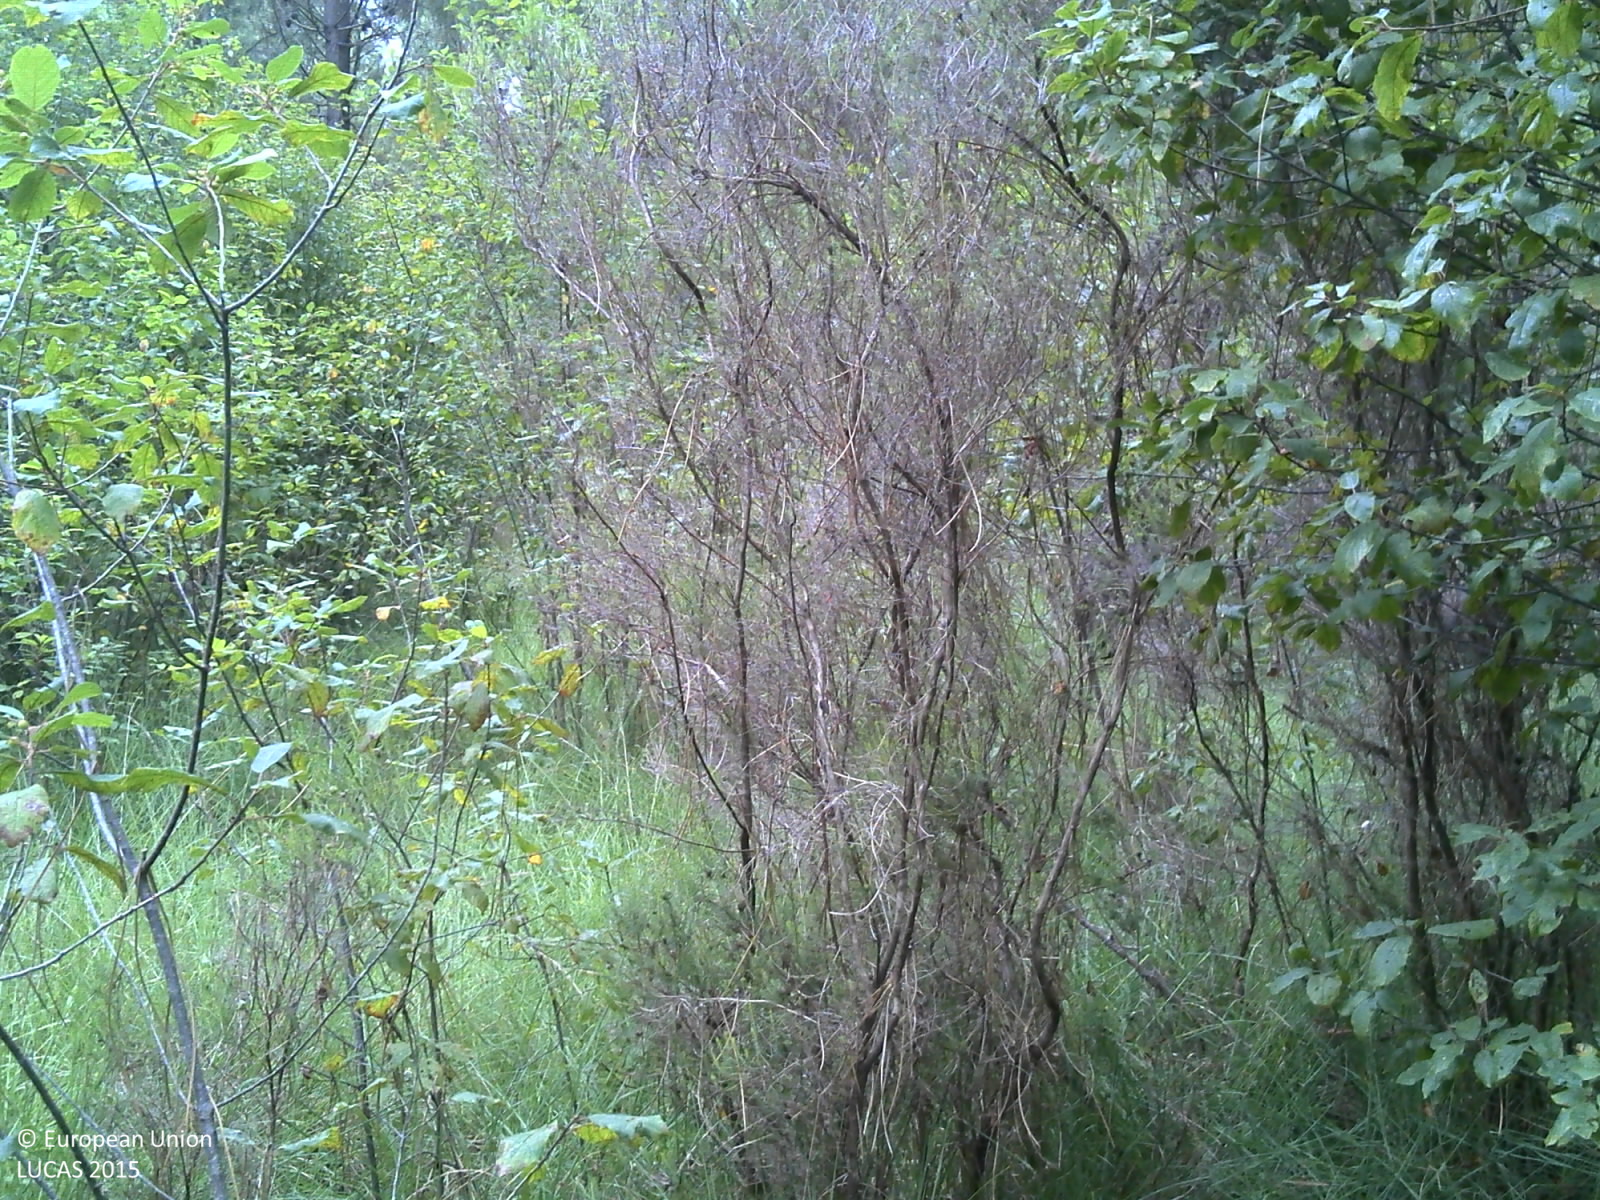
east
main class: Woodland
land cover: Pine dominated coniferous woodland
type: floodplain forest
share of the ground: > 75 %
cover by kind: coniferous forest trees 60 %, shrubs 30 %, herbaceous plants 5 %, lichens and mosses 5 %
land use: Forestry
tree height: > 5 m
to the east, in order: Pine dominated coniferous woodland; Ditches and canals; Pine dominated coniferous woodland; Grass margins; Ditches and canals; Grass margins; Tracks; Grass margins; Pine dominated coniferous woodland
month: July
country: FR
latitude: 44.2883
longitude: -0.3265
